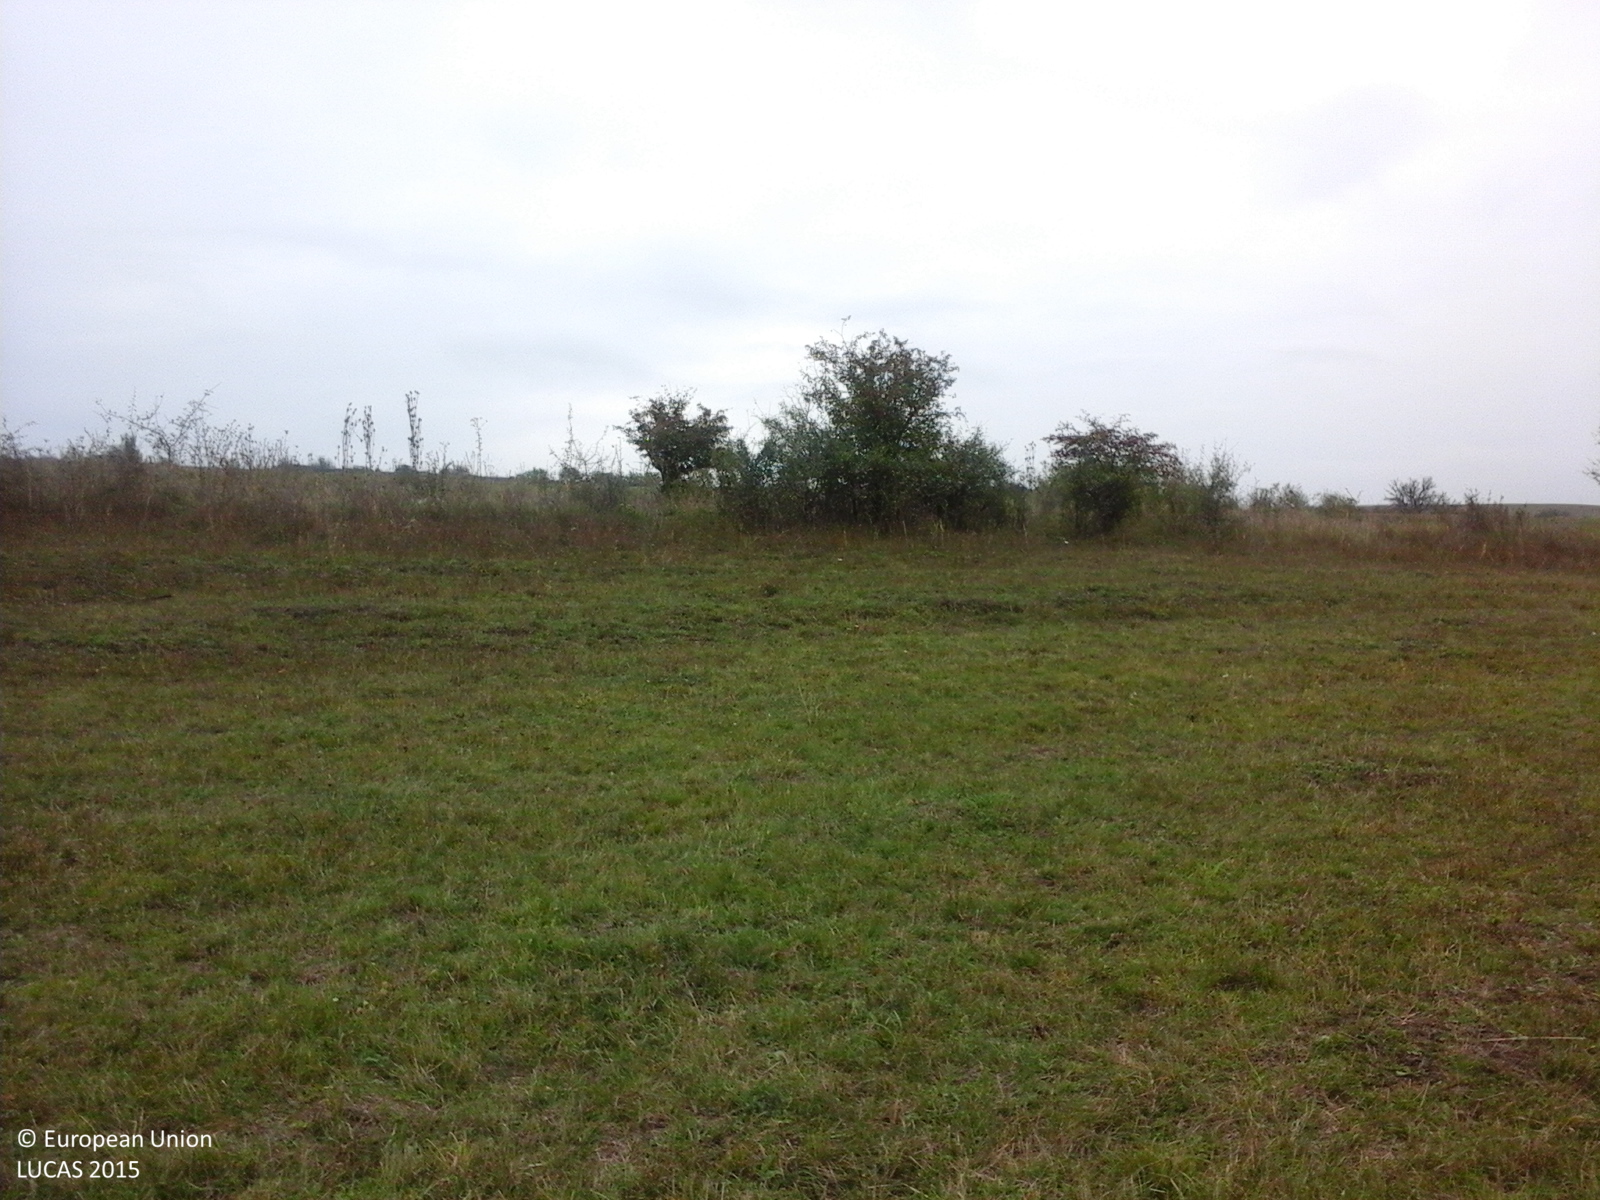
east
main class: Grassland
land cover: Grassland without tree/shrub cover
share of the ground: > 75 %
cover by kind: herbaceous plants 100 %
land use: Agriculture (excluding fallow land and kitchen gardens)
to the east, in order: Grassland without tree/shrub cover; Shrubland with sparse tree cover; Grassland without tree/shrub cover; Shrubland without tree cover; Grassland without tree/shrub cover
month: October
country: RO
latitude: 46.1317
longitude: 25.2304
